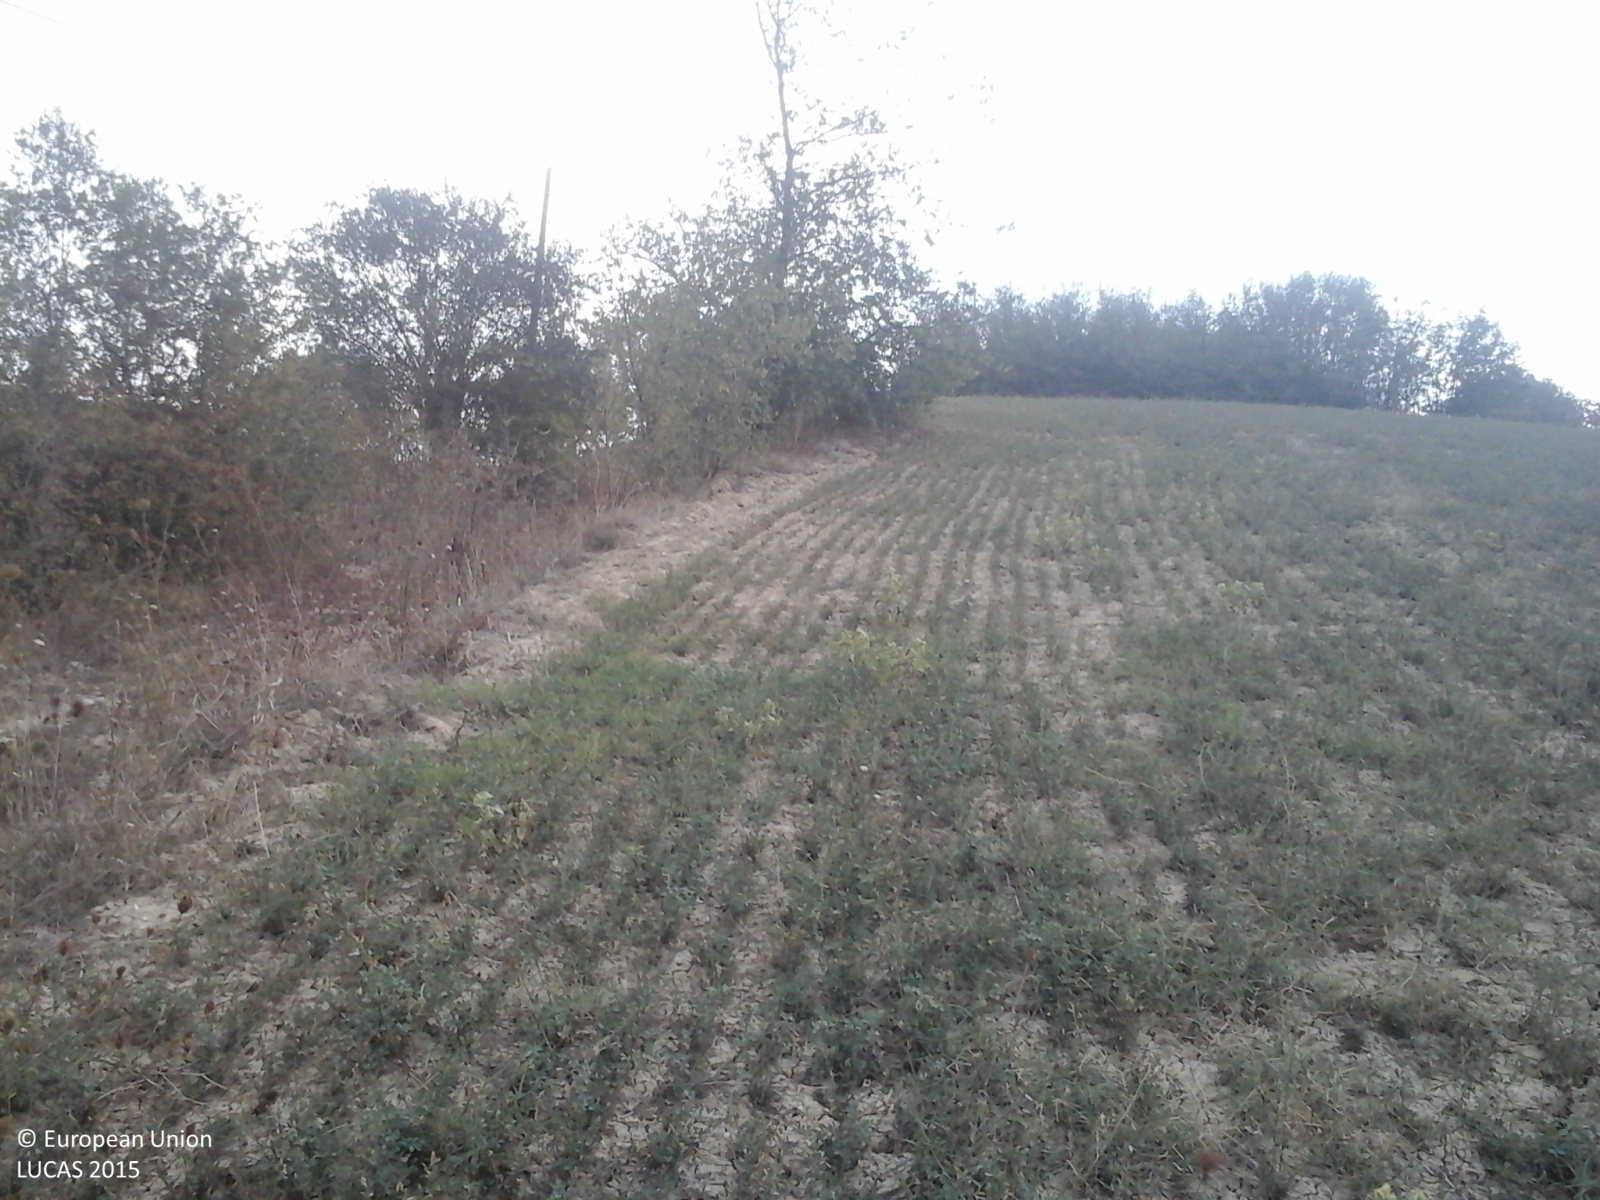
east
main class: Cropland
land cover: Lucerne
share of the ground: > 75 %
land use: Agriculture (excluding fallow land and kitchen gardens)
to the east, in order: Lucerne; Abandoned hedges; Tracks; Abandoned hedges; Electric lines; Other bare soil
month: September
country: IT
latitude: 42.7972
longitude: 13.8650
